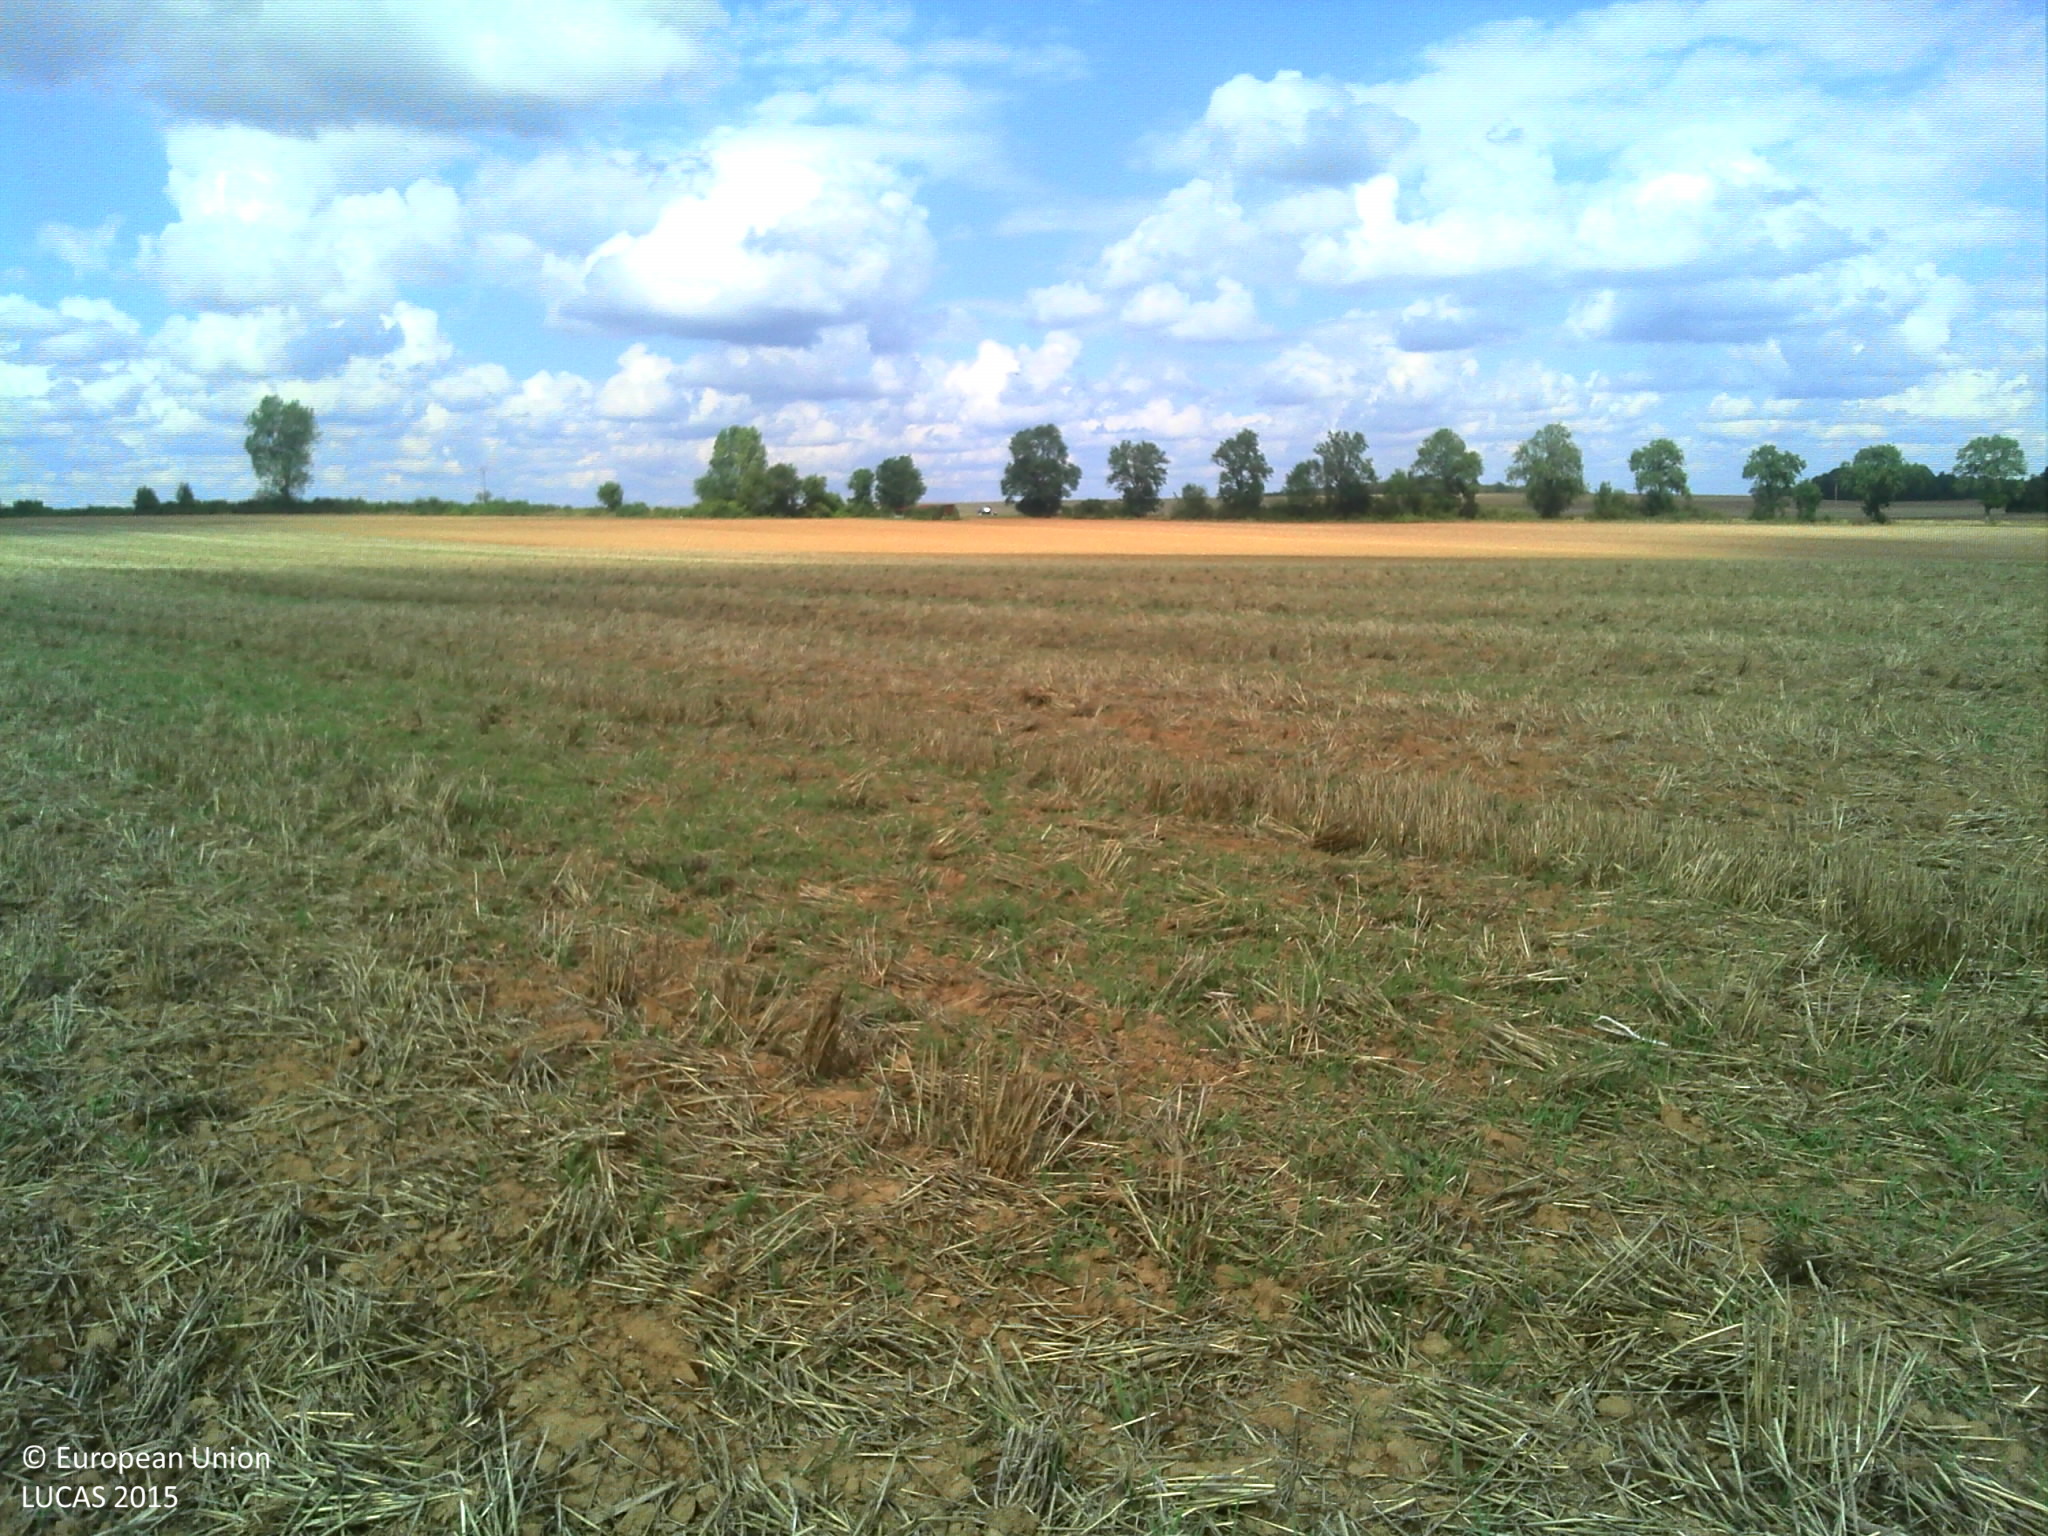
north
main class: Cropland
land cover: Common wheat
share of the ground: 10 - 25 %
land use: Agriculture (excluding fallow land and kitchen gardens)
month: September
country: FR
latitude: 48.7989
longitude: 5.9836
